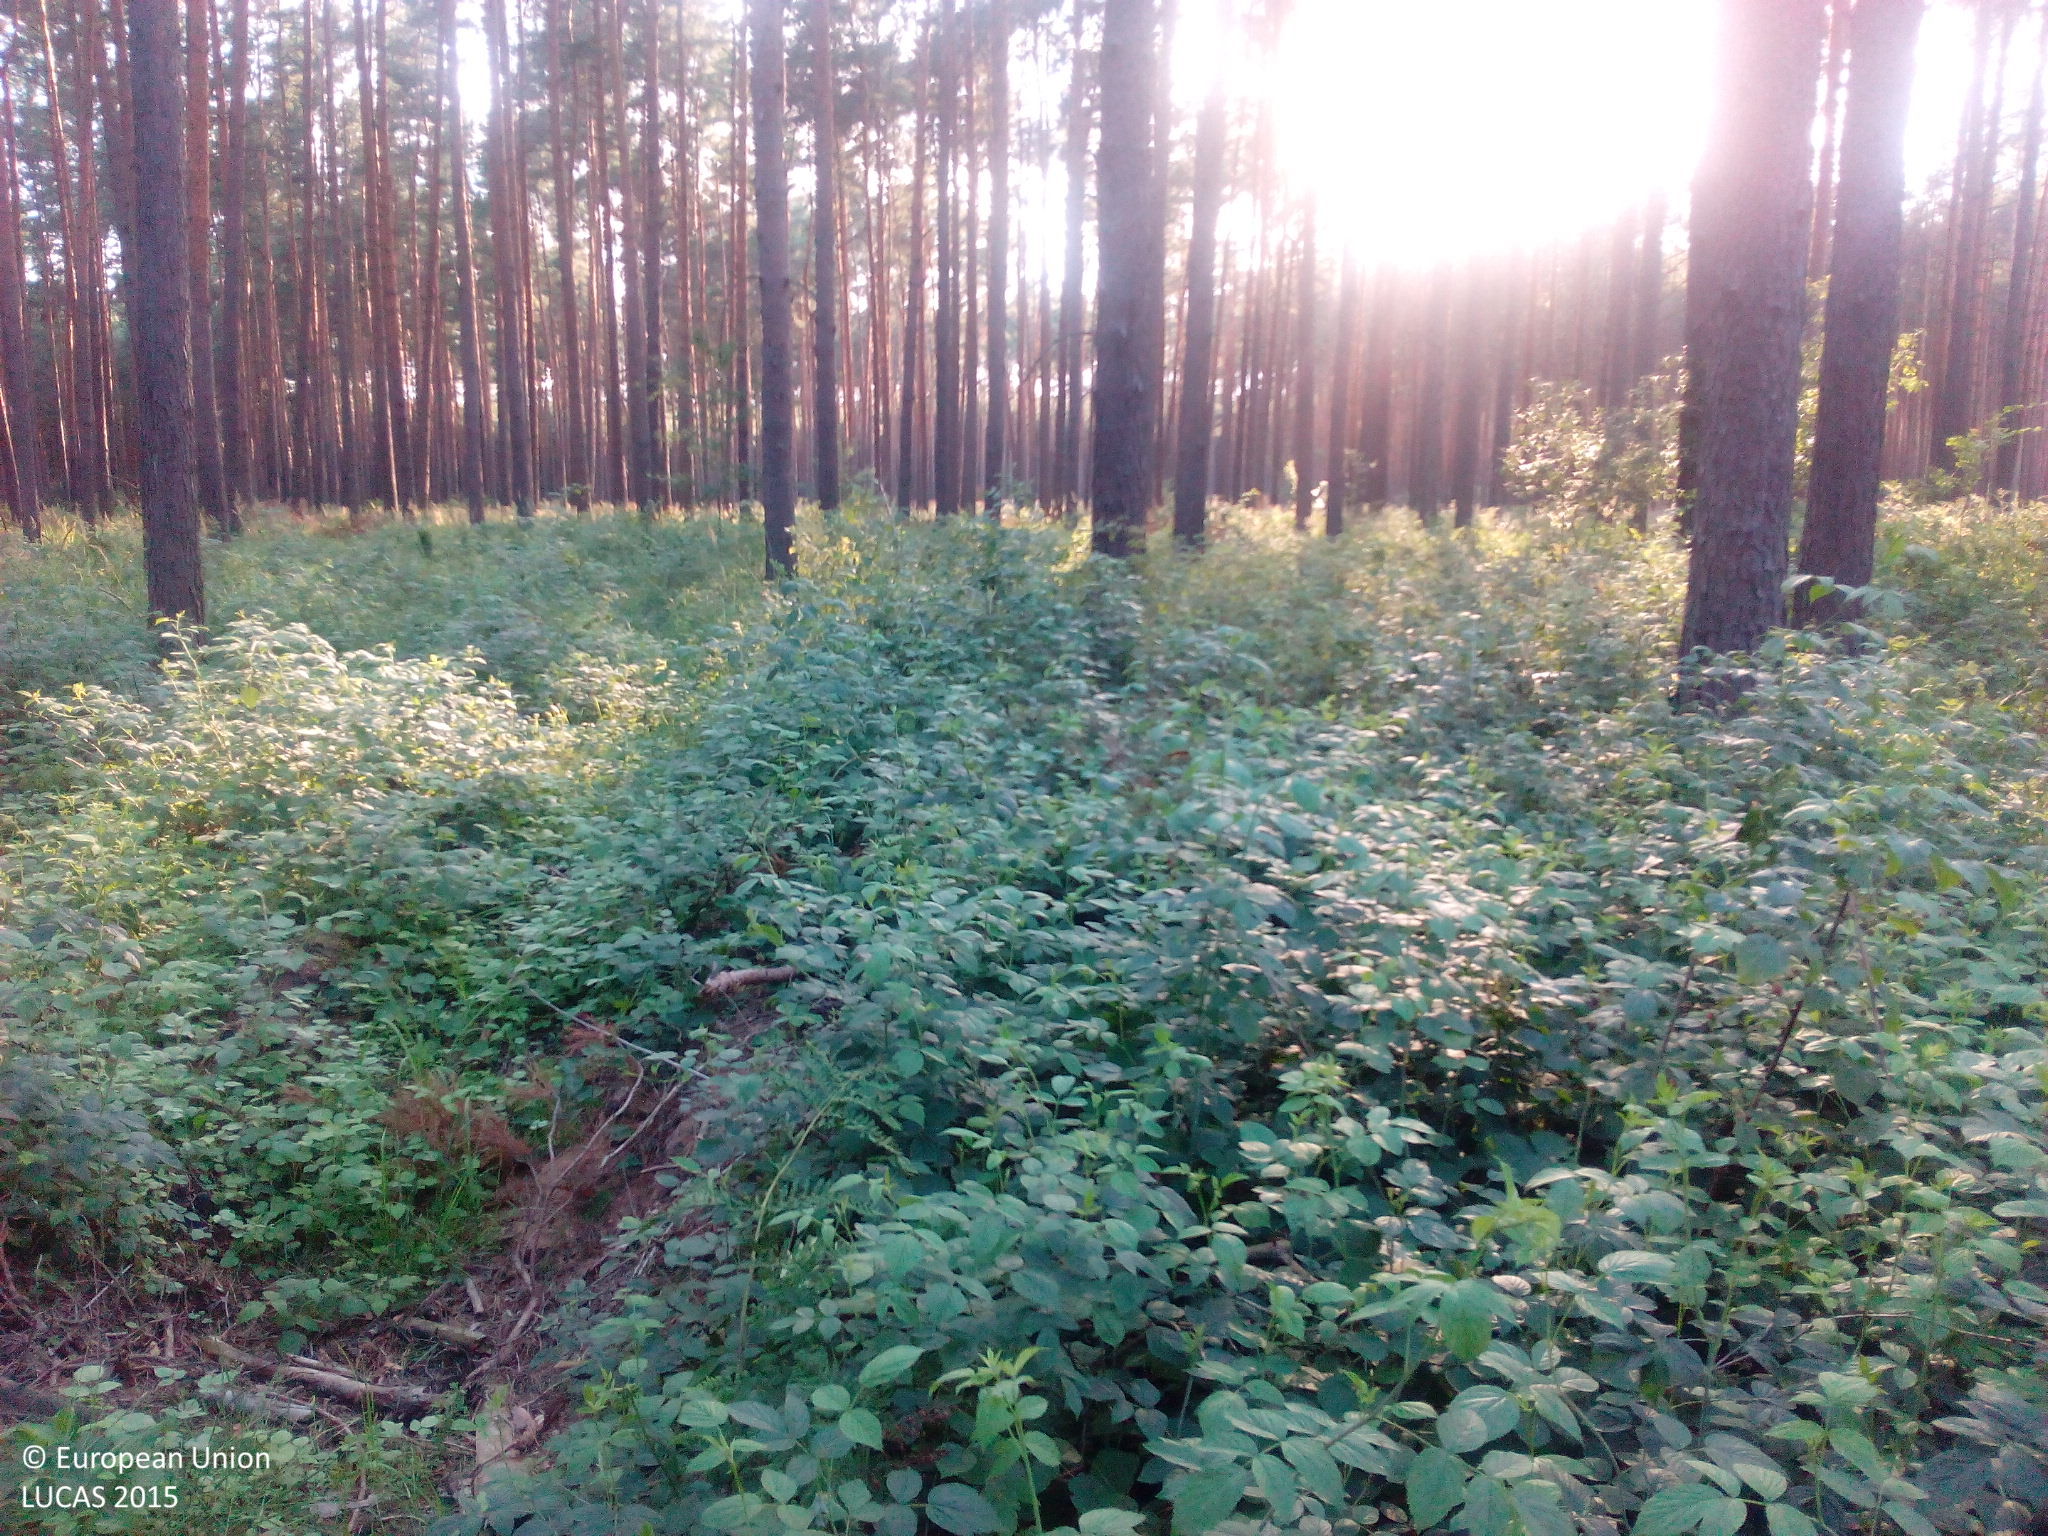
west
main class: Woodland
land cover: Pine dominated coniferous woodland
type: hemiboreal forest and nemoral coniferous forest and mixed broadleaved-coniferous forest
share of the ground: > 75 %
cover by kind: coniferous forest trees 90 %, shrubs 10 %
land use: Forestry
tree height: > 5 m
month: July
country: DE
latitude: 51.9941
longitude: 12.3736
